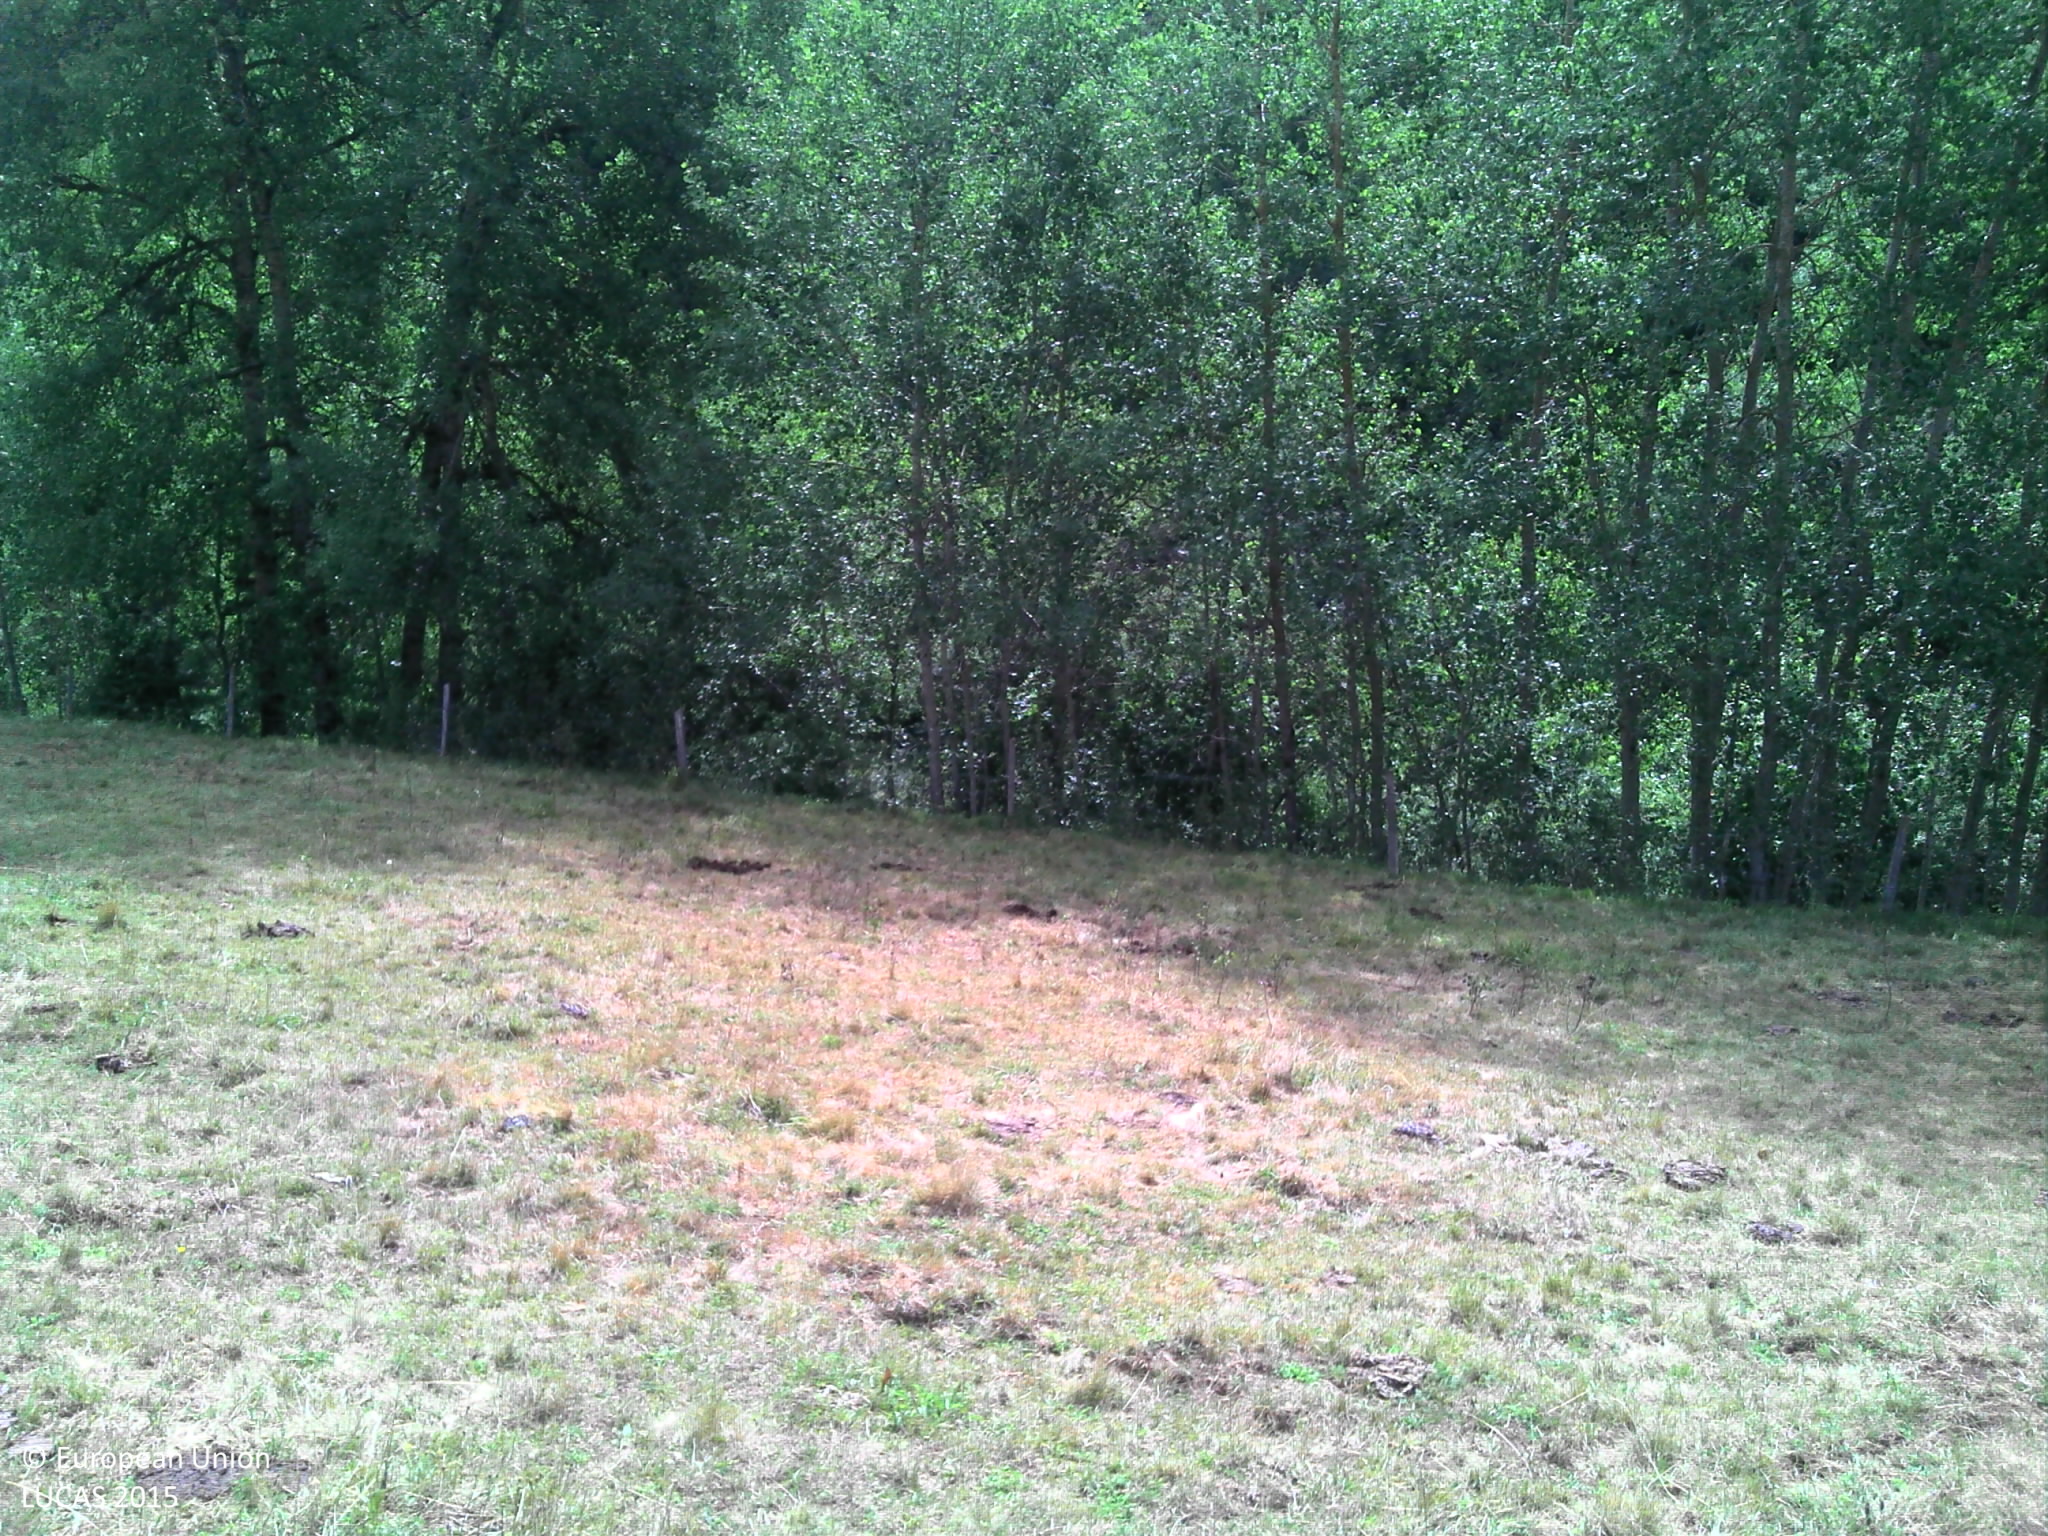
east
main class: Grassland
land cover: Grassland without tree/shrub cover
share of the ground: > 75 %
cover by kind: herbaceous plants 100 %
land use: Agriculture (excluding fallow land and kitchen gardens)
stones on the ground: < 10 %
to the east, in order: Grassland without tree/shrub cover; Fences; Broadleaved woodland; Inland fresh running water; Broadleaved woodland
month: July
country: FR
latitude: 44.7319
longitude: 3.9063
